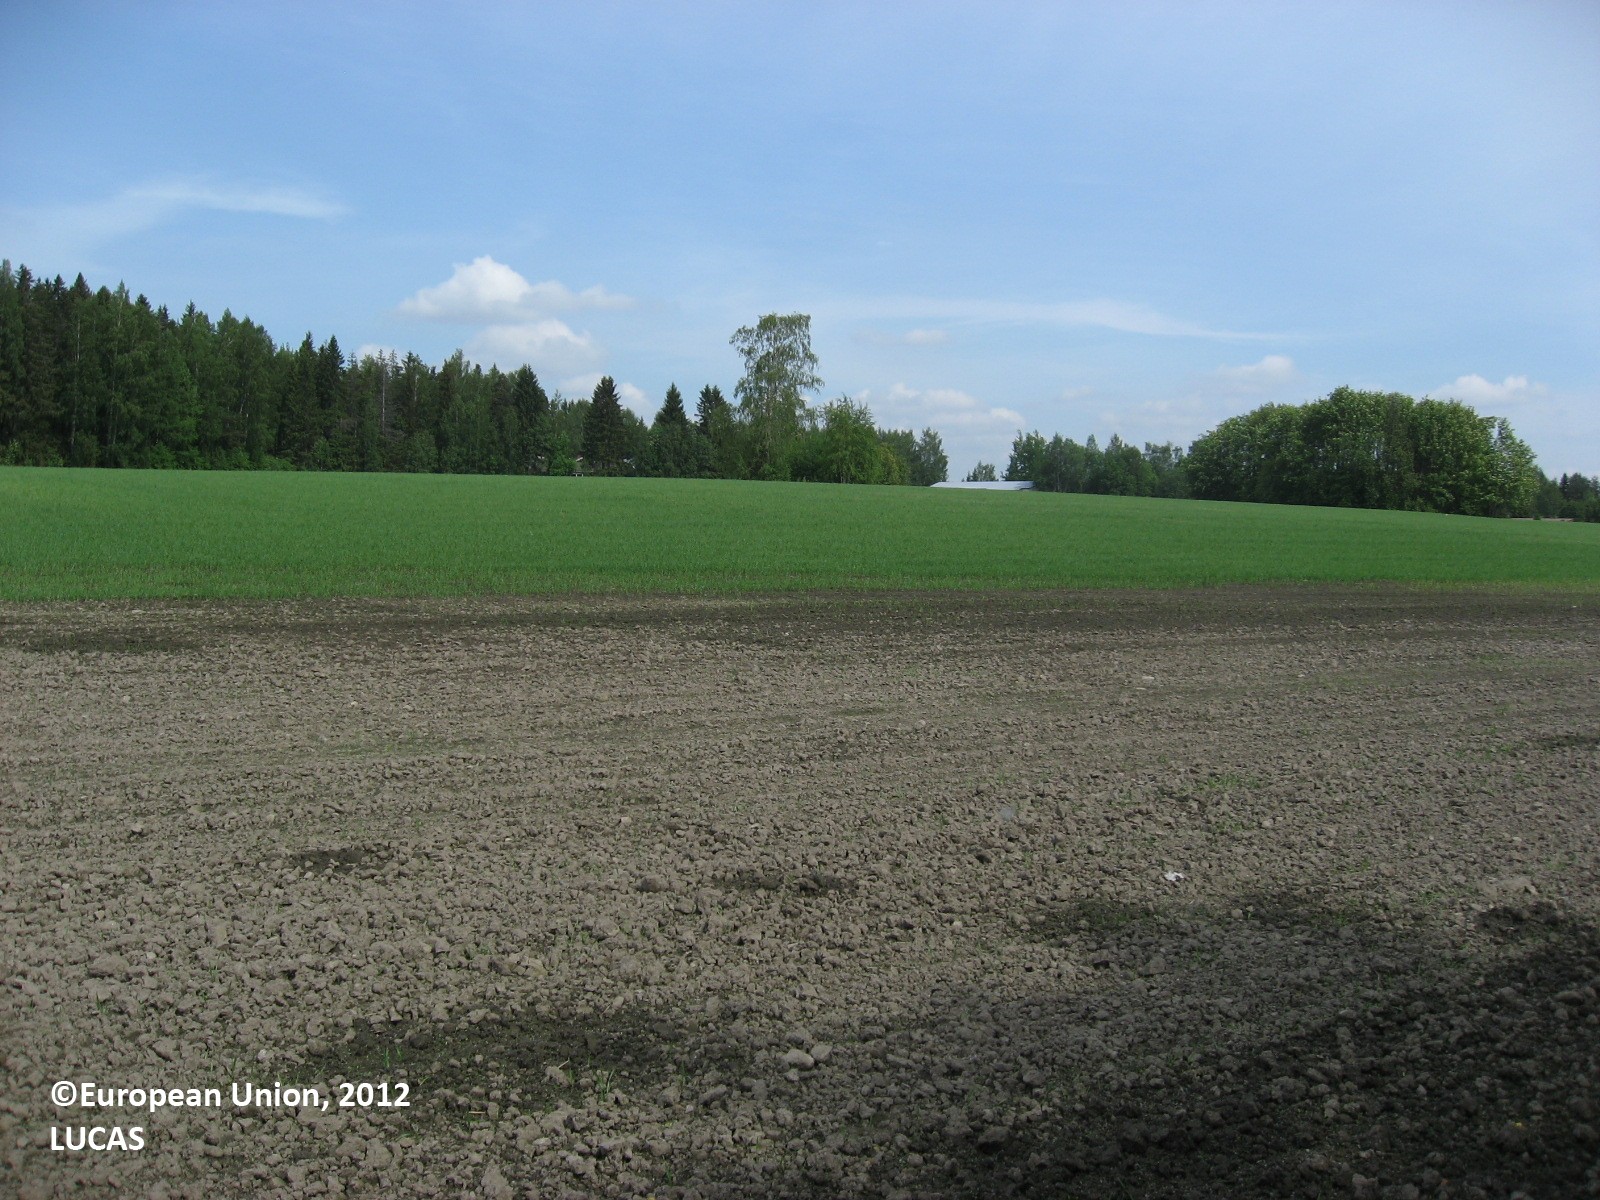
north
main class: Cropland
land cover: Common wheat
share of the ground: < 10 %
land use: Agriculture (excluding fallow land and kitchen gardens)
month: June
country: FI
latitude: 60.3852
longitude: 24.9755
